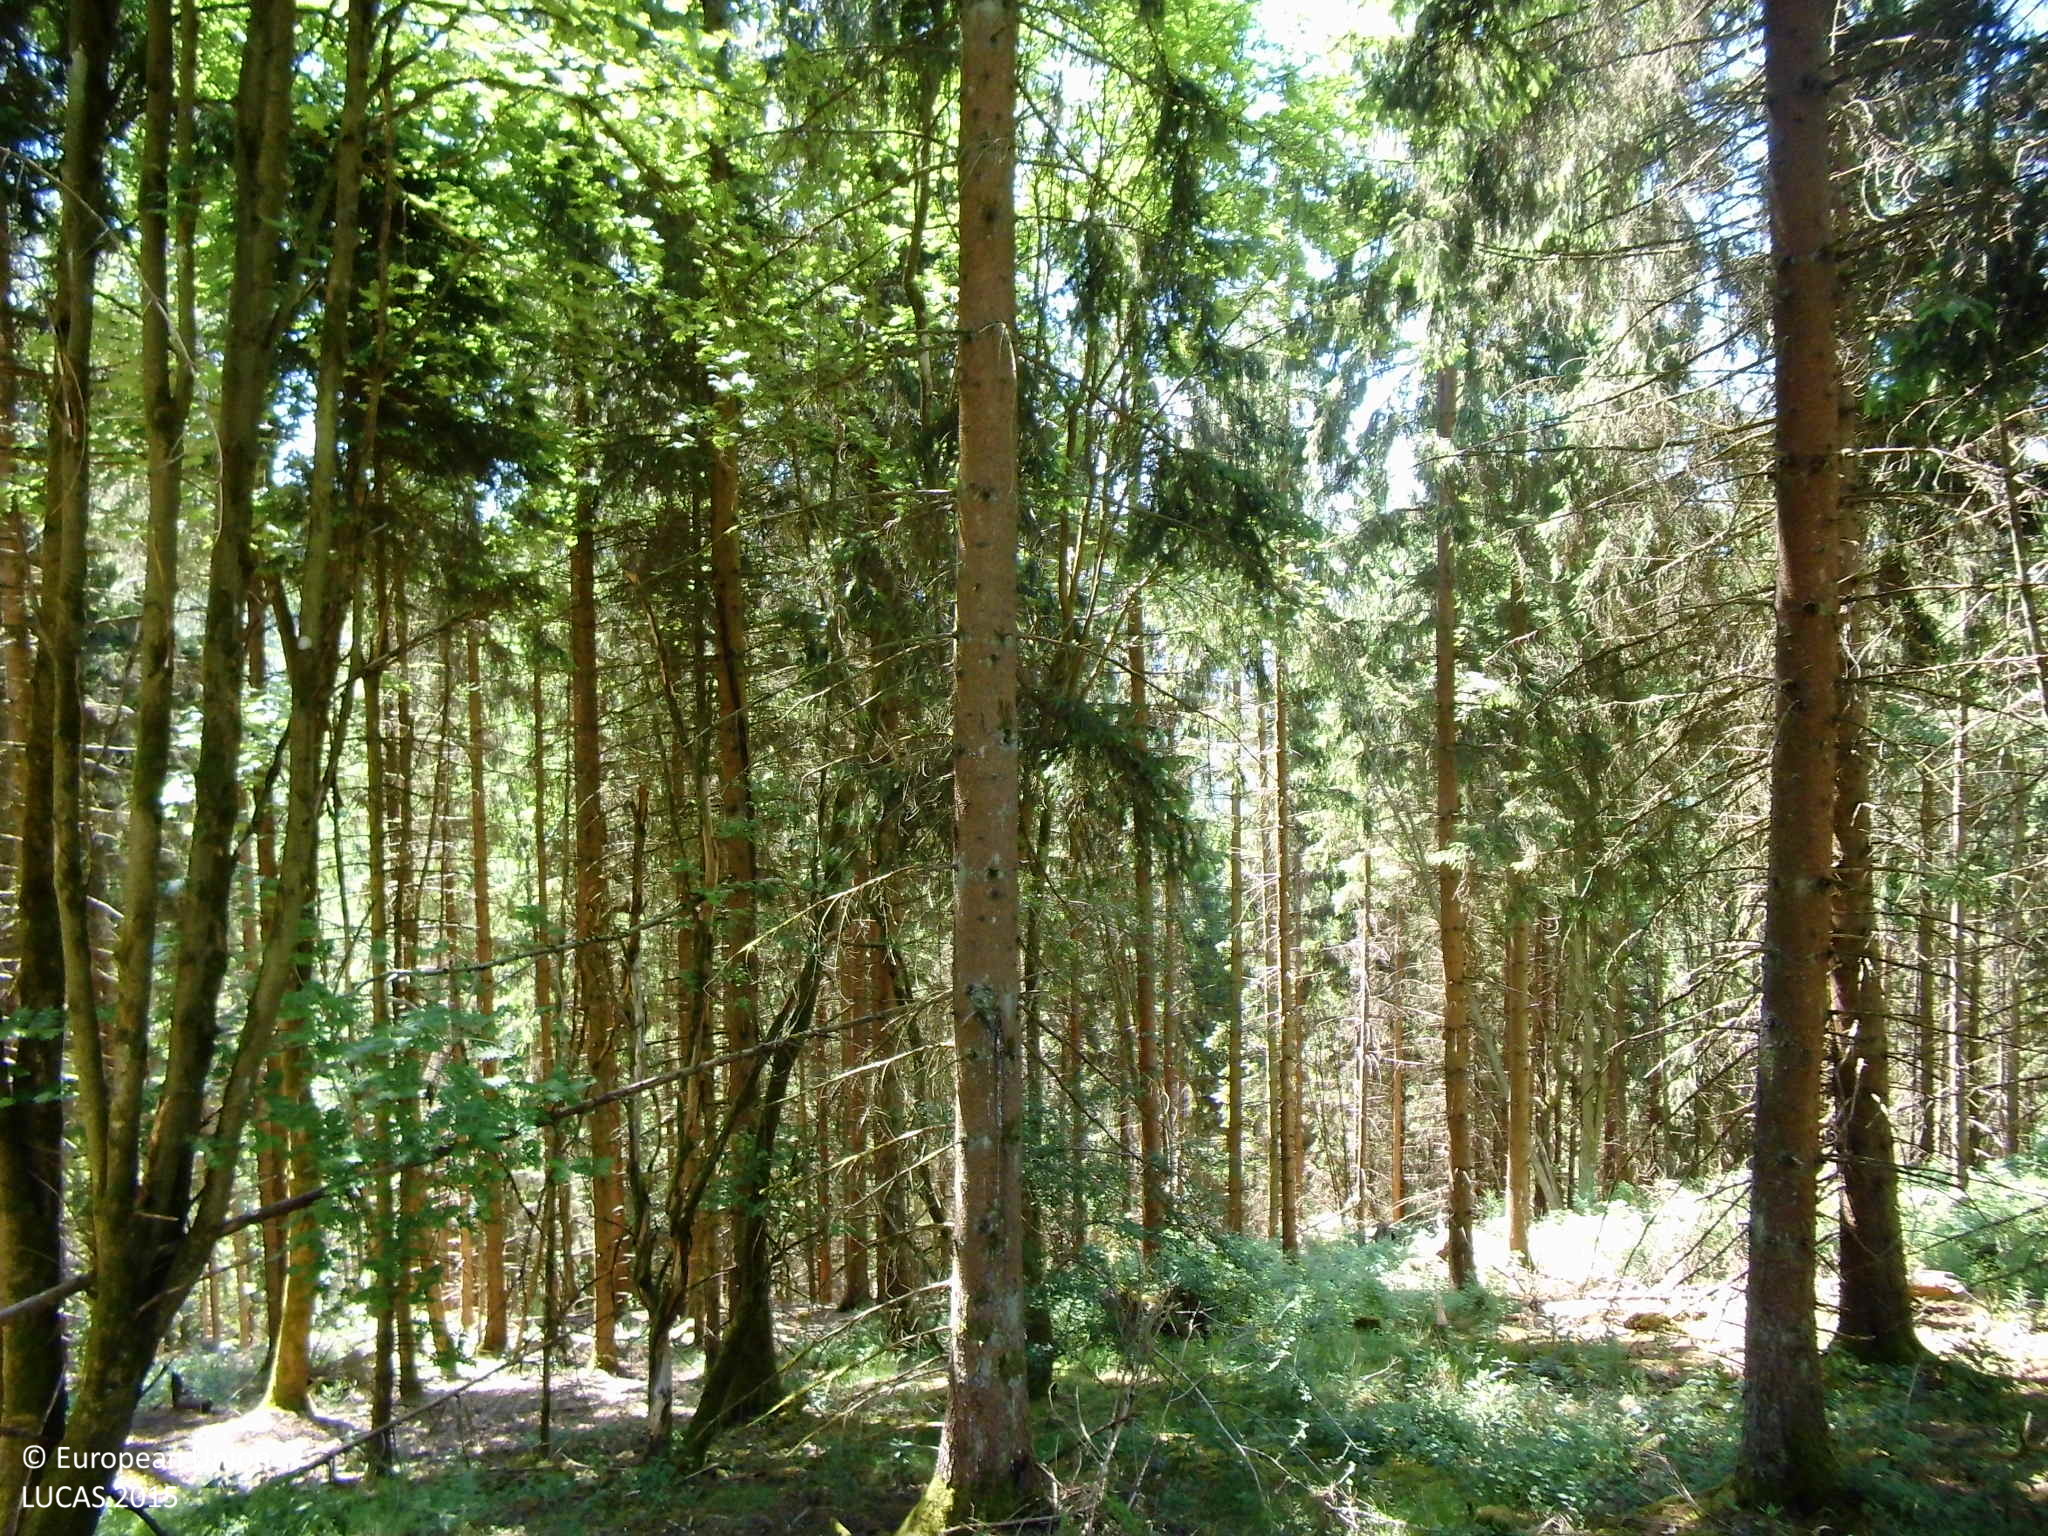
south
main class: Woodland
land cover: Spruce dominated coniferous woodland
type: hemiboreal forest and nemoral coniferous forest and mixed broadleaved-coniferous forest
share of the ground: > 75 %
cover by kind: coniferous forest trees 75 %, broadleaved forest trees 10 %, herbaceous plants 10 %, lichens and mosses 5 %
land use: Forestry
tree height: > 5 m
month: June
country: DE
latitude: 50.9290
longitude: 8.4495
